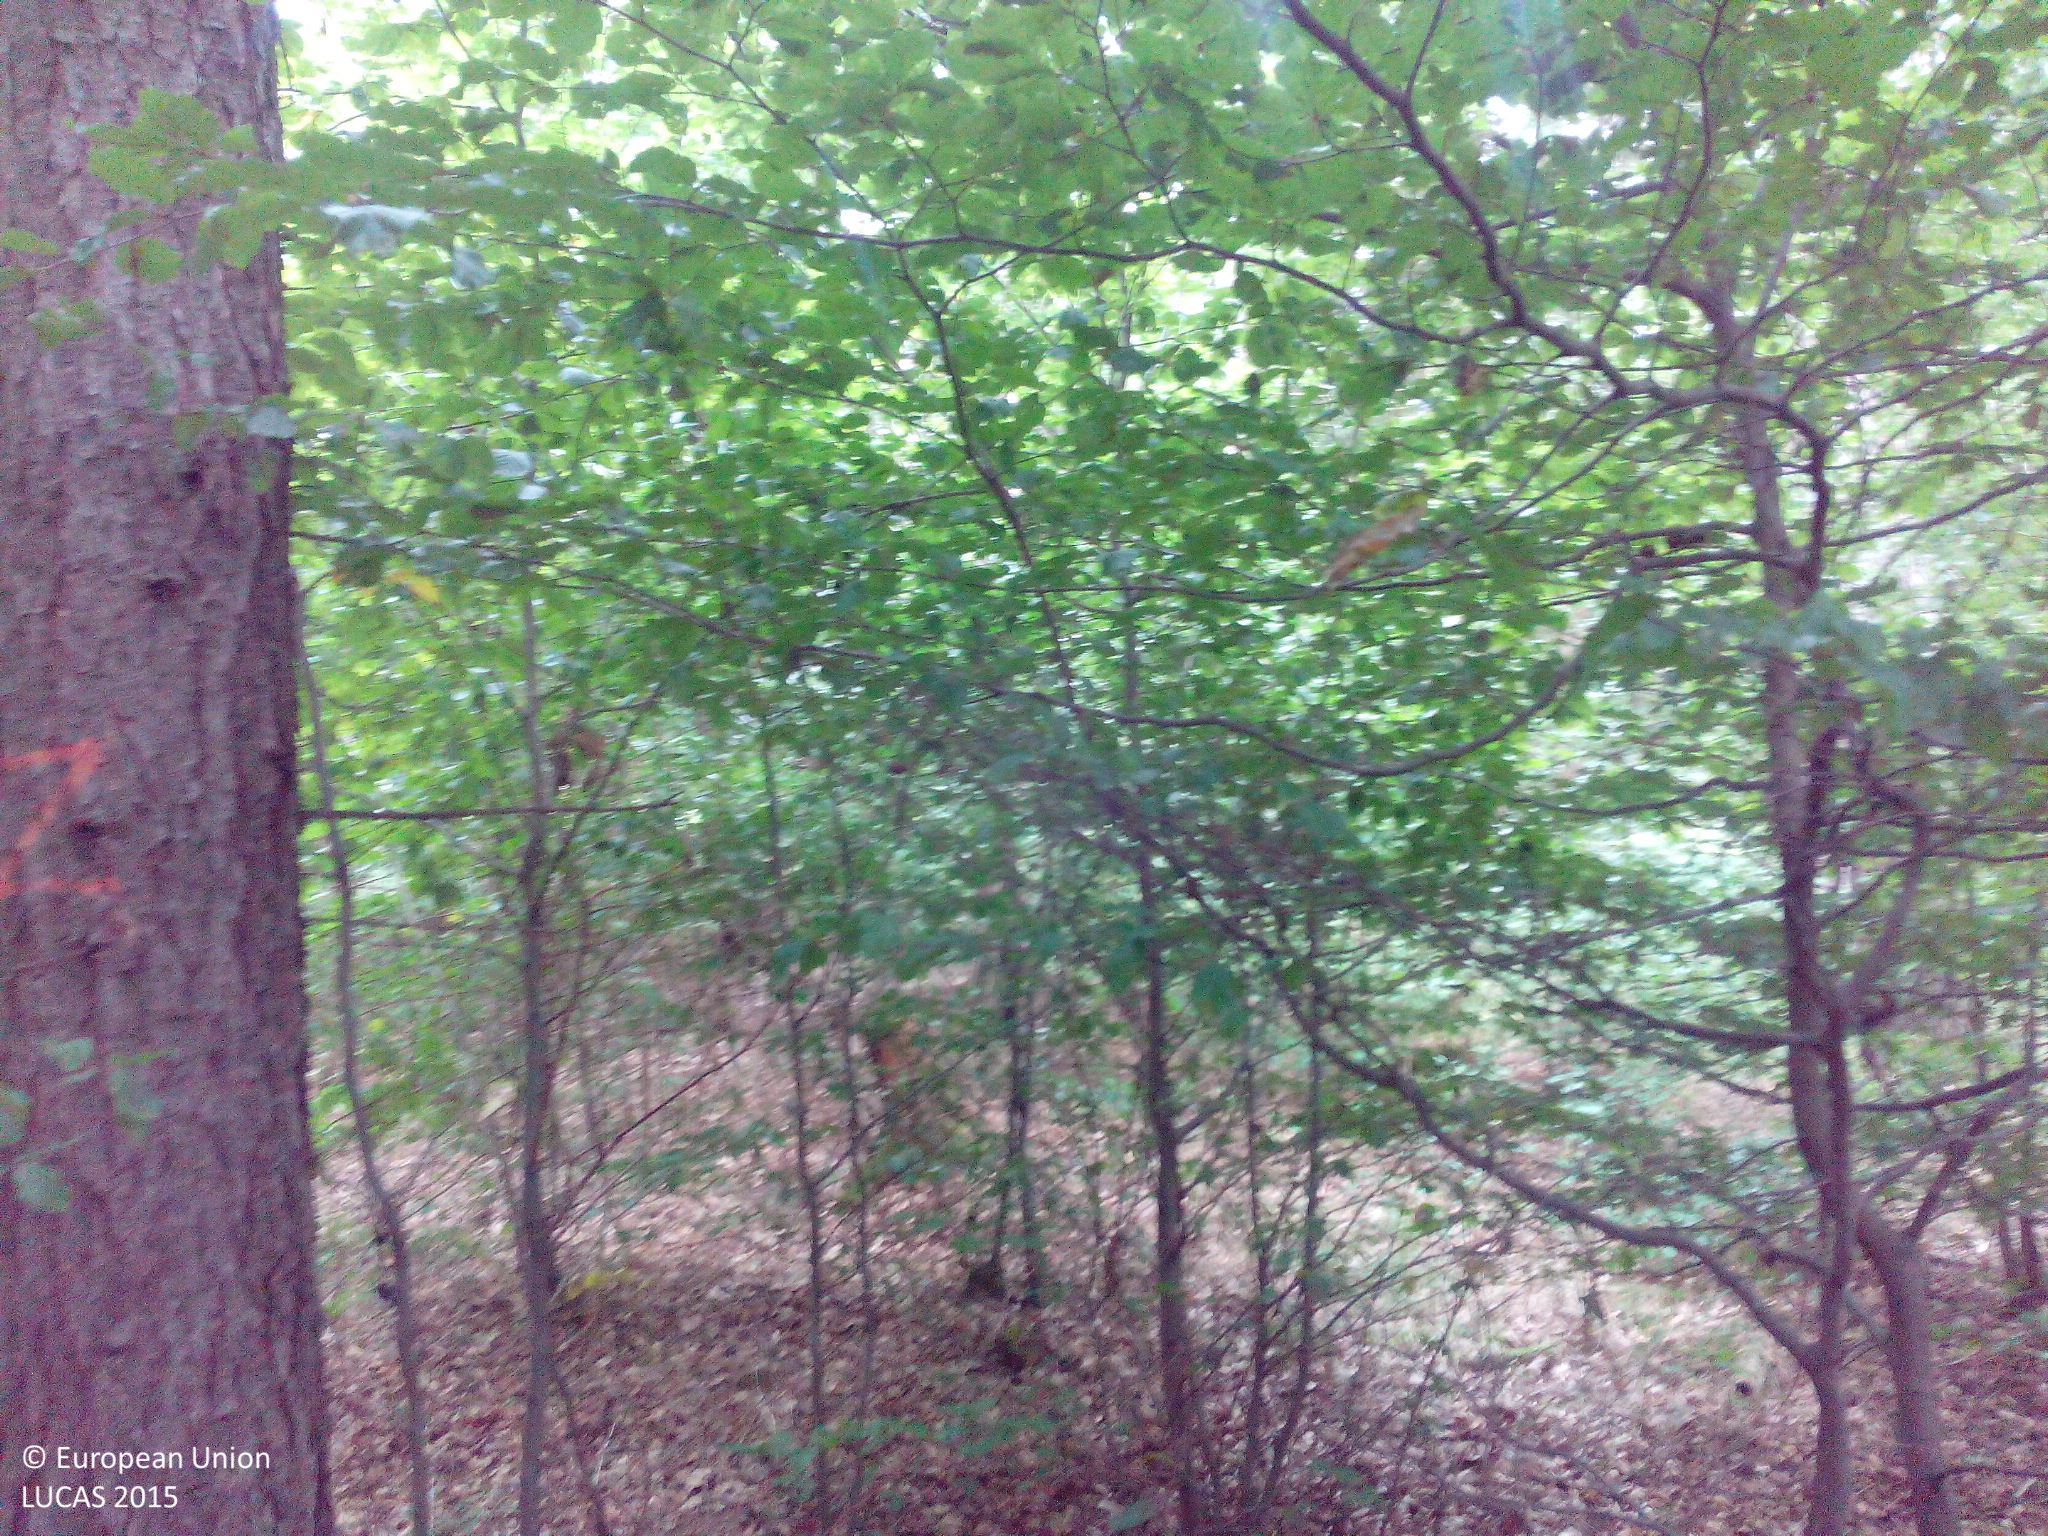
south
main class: Woodland
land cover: Other mixed woodland
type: hemiboreal forest and nemoral coniferous forest and mixed broadleaved-coniferous forest
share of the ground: > 75 %
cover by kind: coniferous forest trees 60 %, broadleaved forest trees 40 %
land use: Forestry
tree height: > 5 m
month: September
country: DE
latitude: 51.6535
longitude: 11.0838
